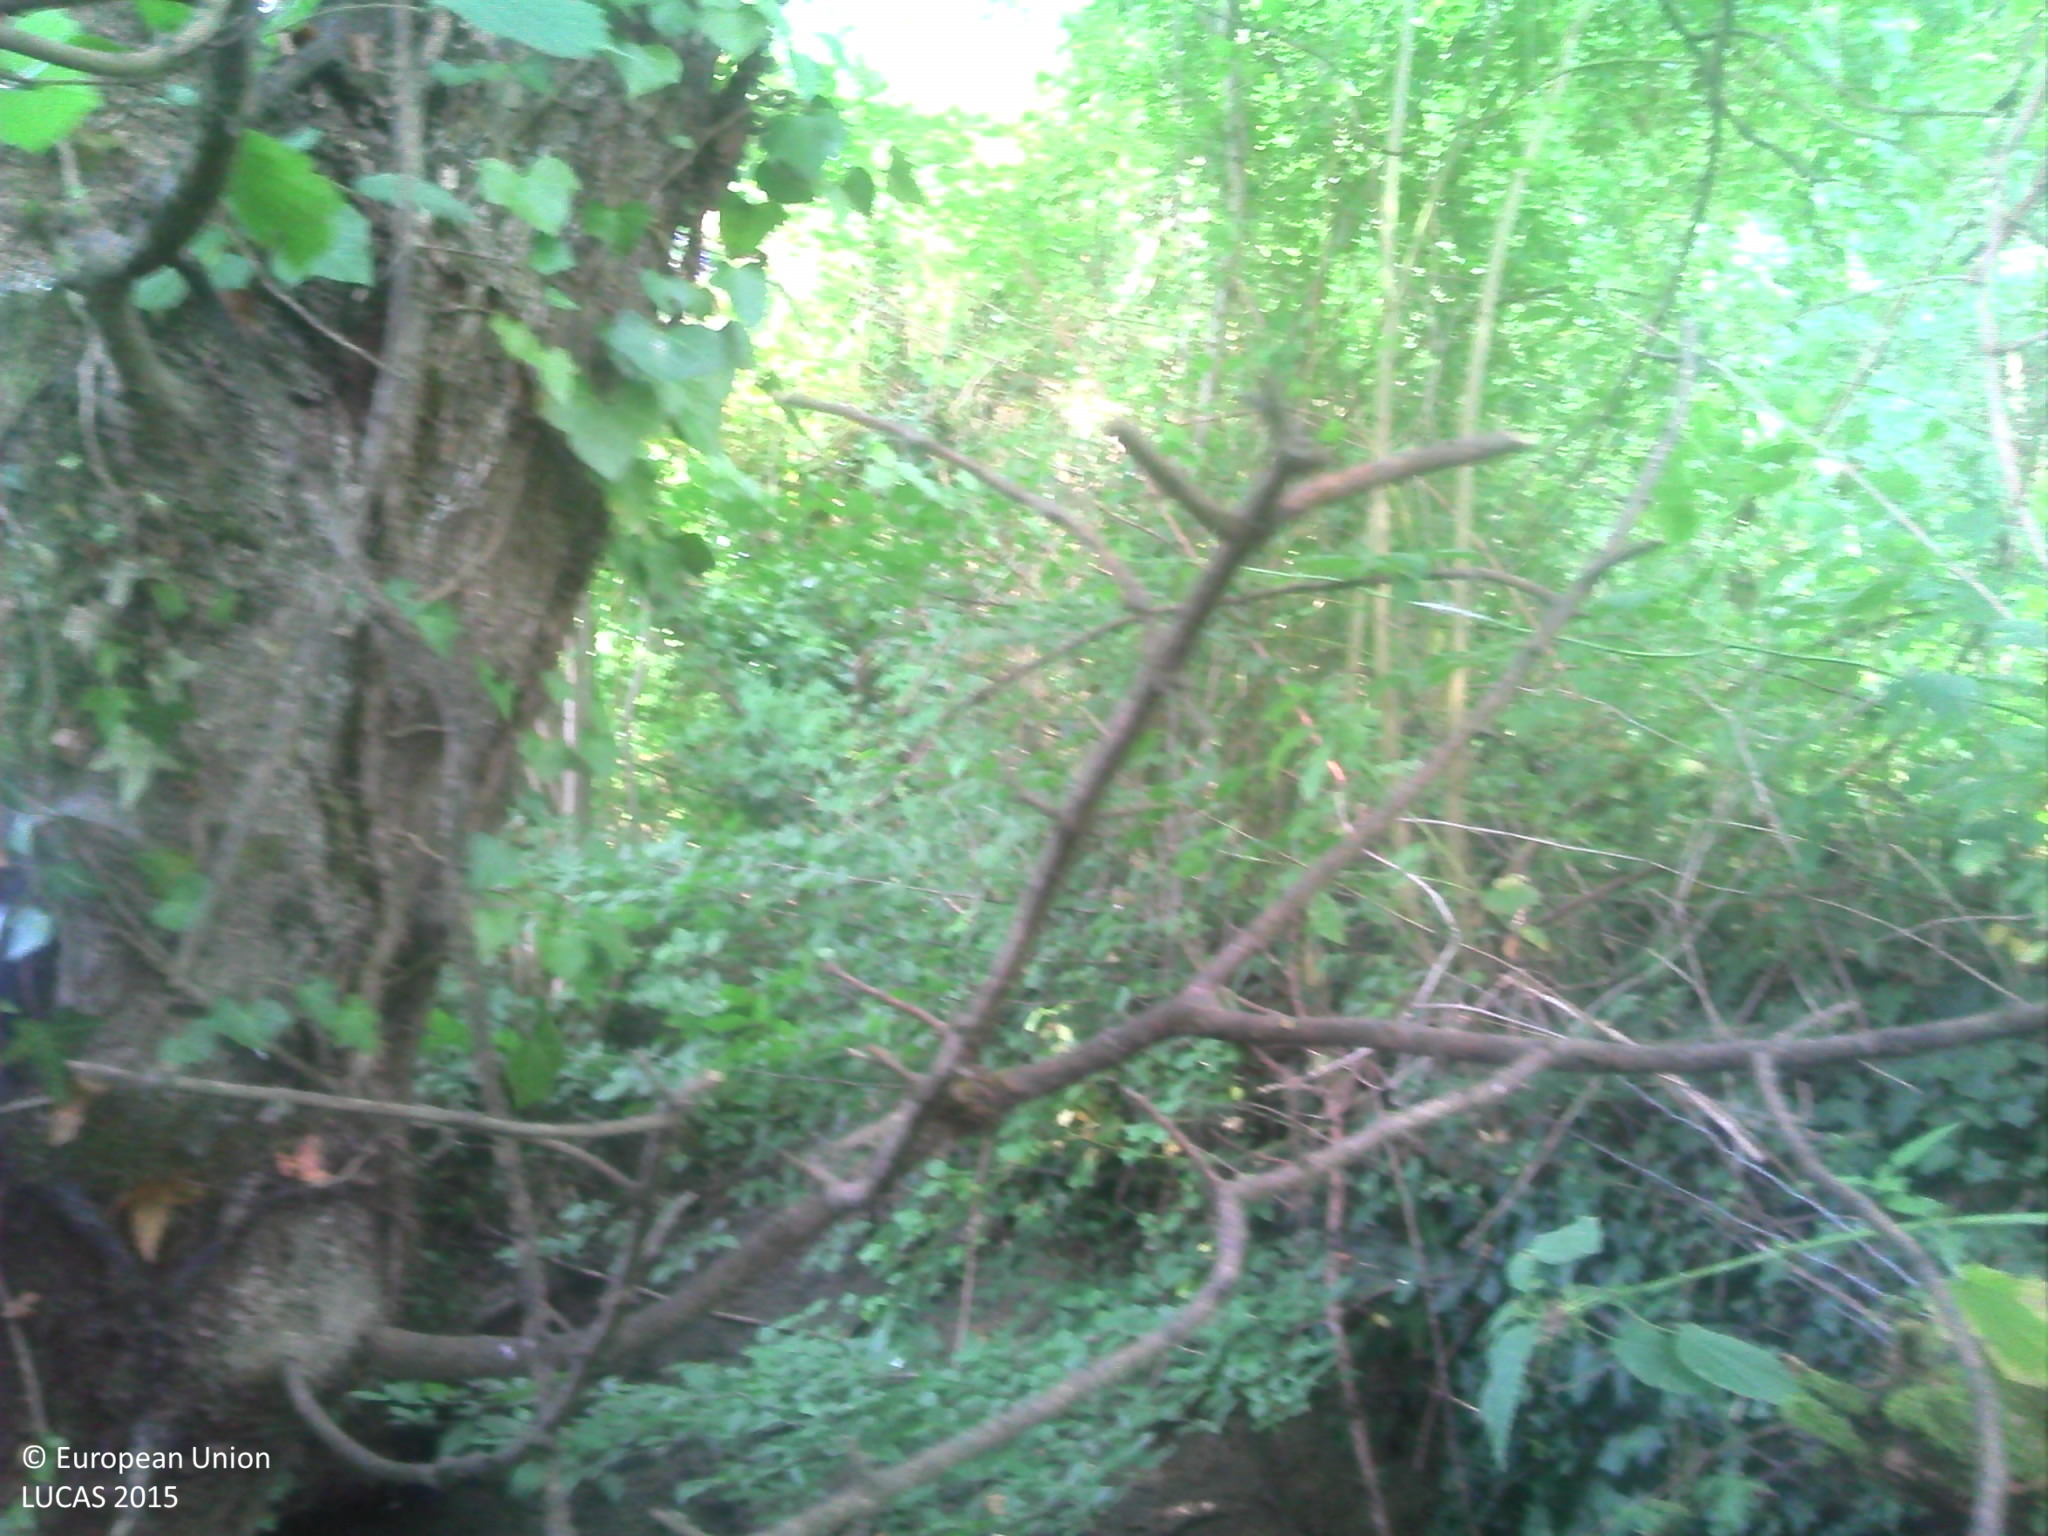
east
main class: Woodland
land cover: Broadleaved woodland
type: acidophilous oak and oak-birch forest
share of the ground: > 75 %
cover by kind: broadleaved forest trees 65 %, herbaceous plants 35 %
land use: Forestry
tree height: > 5 m
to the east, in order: Broadleaved woodland; Rivers and streams; Spontaneously vegetated surfaces; Broadleaved woodland; Grassland with sparse tree/shrub cover; Tracks; Grassland without tree/shrub cover; Fences; Lines of trees; Grass margins; Common wheat
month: July
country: FR
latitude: 43.6099
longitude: 1.5904
